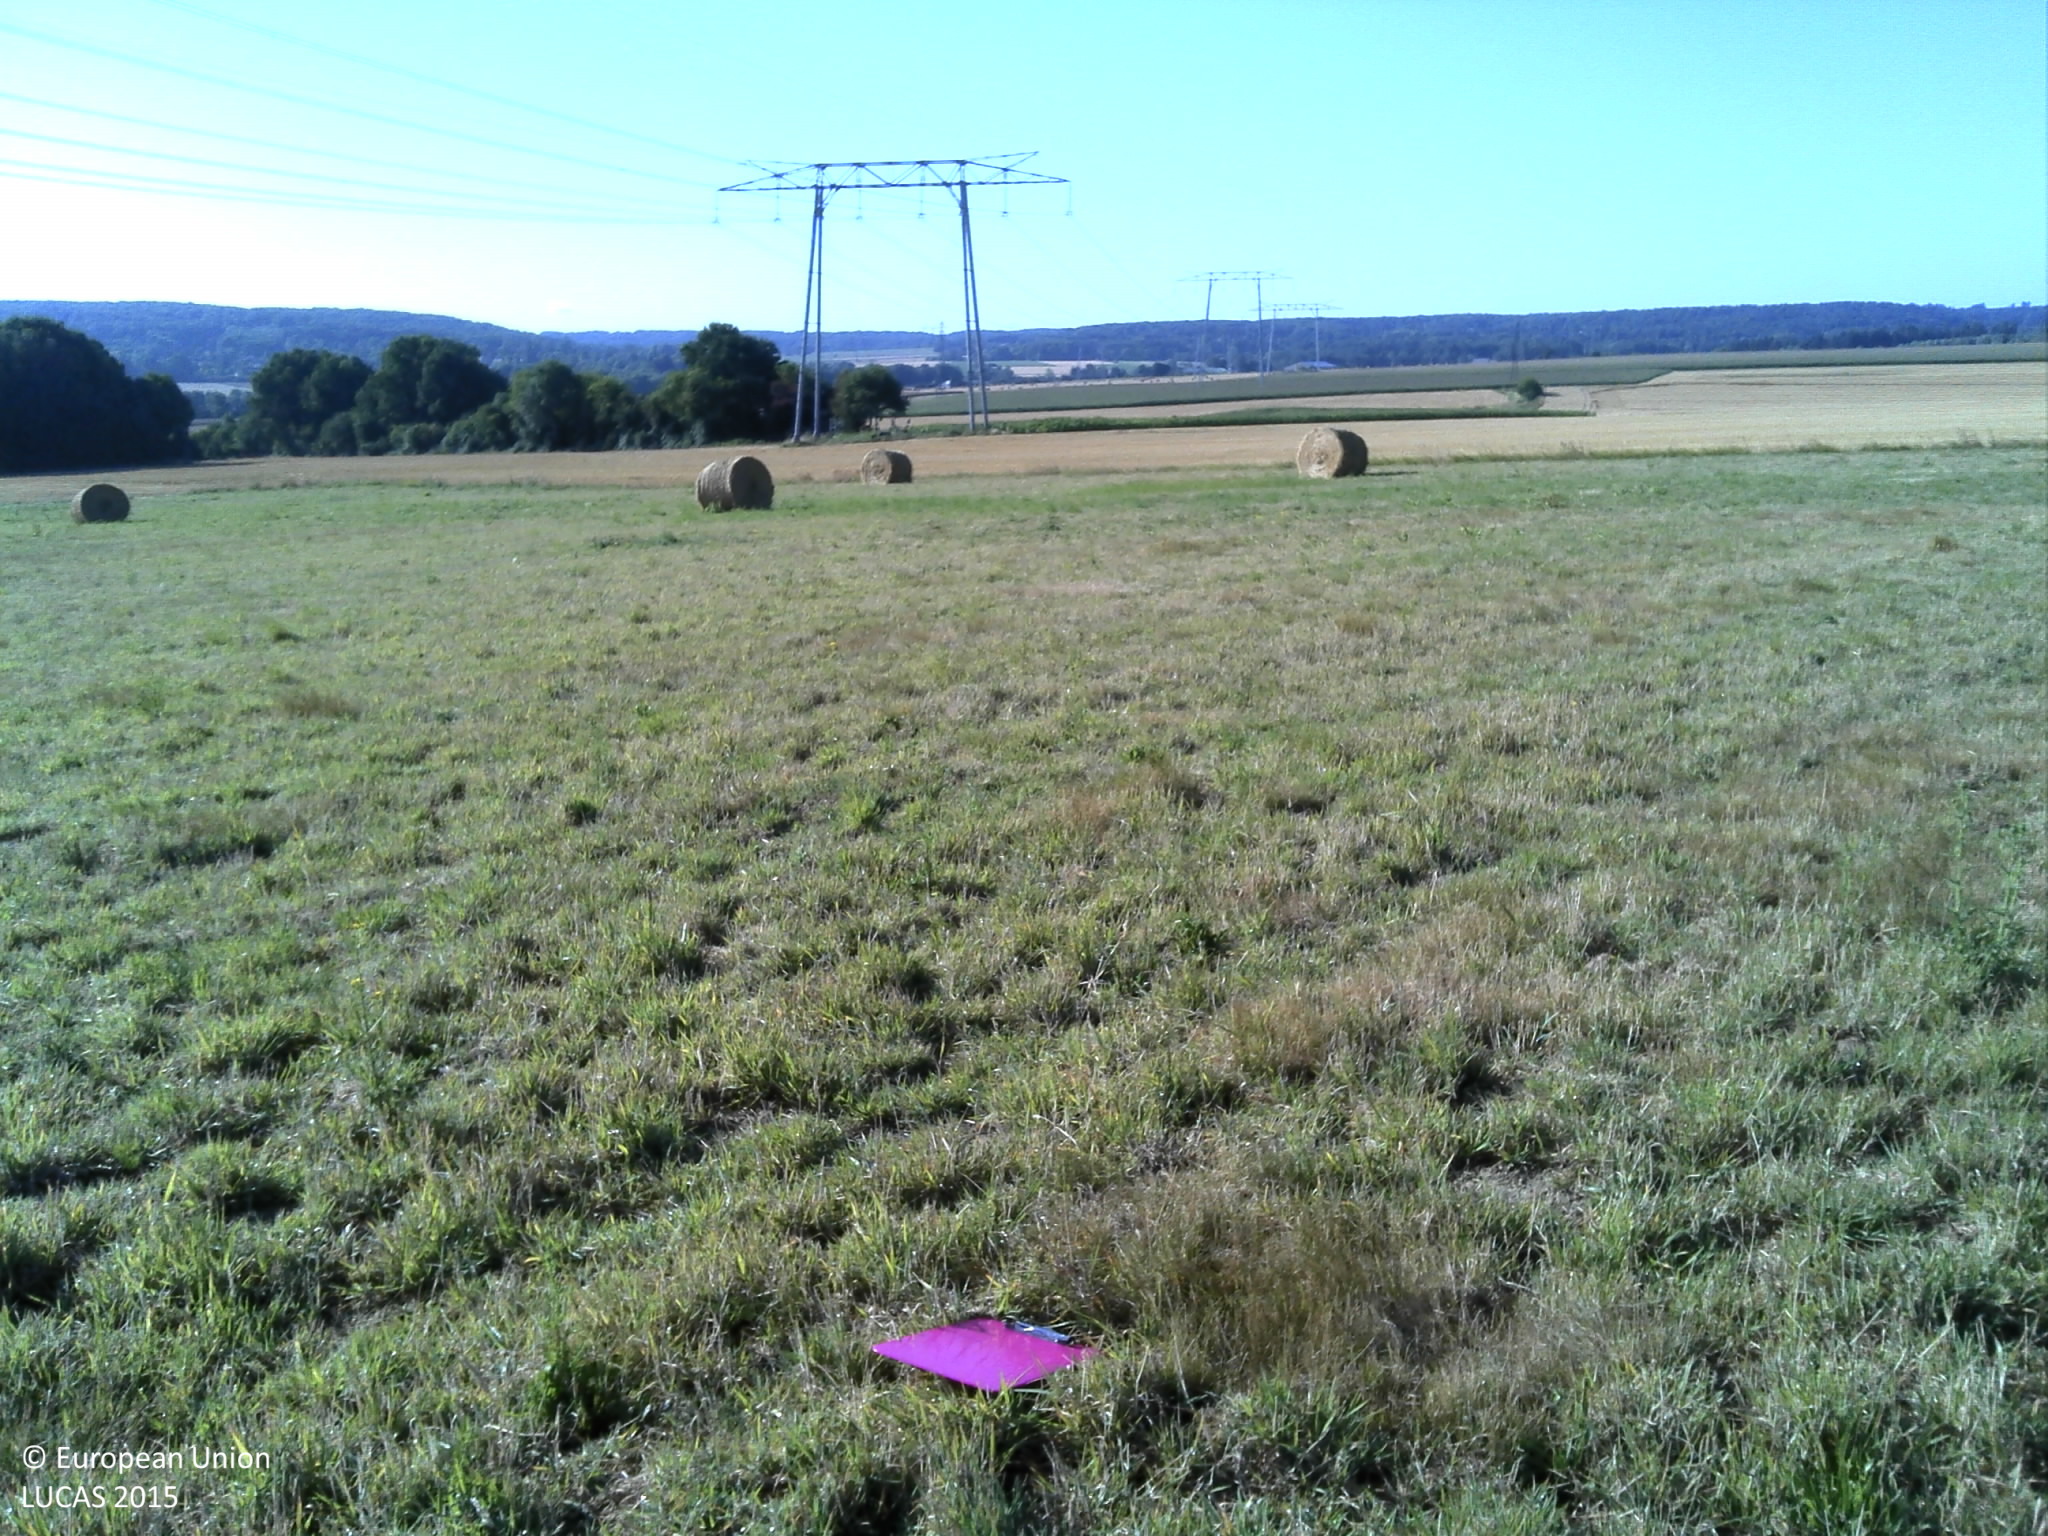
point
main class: Grassland
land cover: Grassland without tree/shrub cover
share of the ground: > 75 %
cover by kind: herbaceous plants 100 %
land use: Agriculture (excluding fallow land and kitchen gardens)
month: July
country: FR
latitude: 48.7881
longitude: 1.8318
